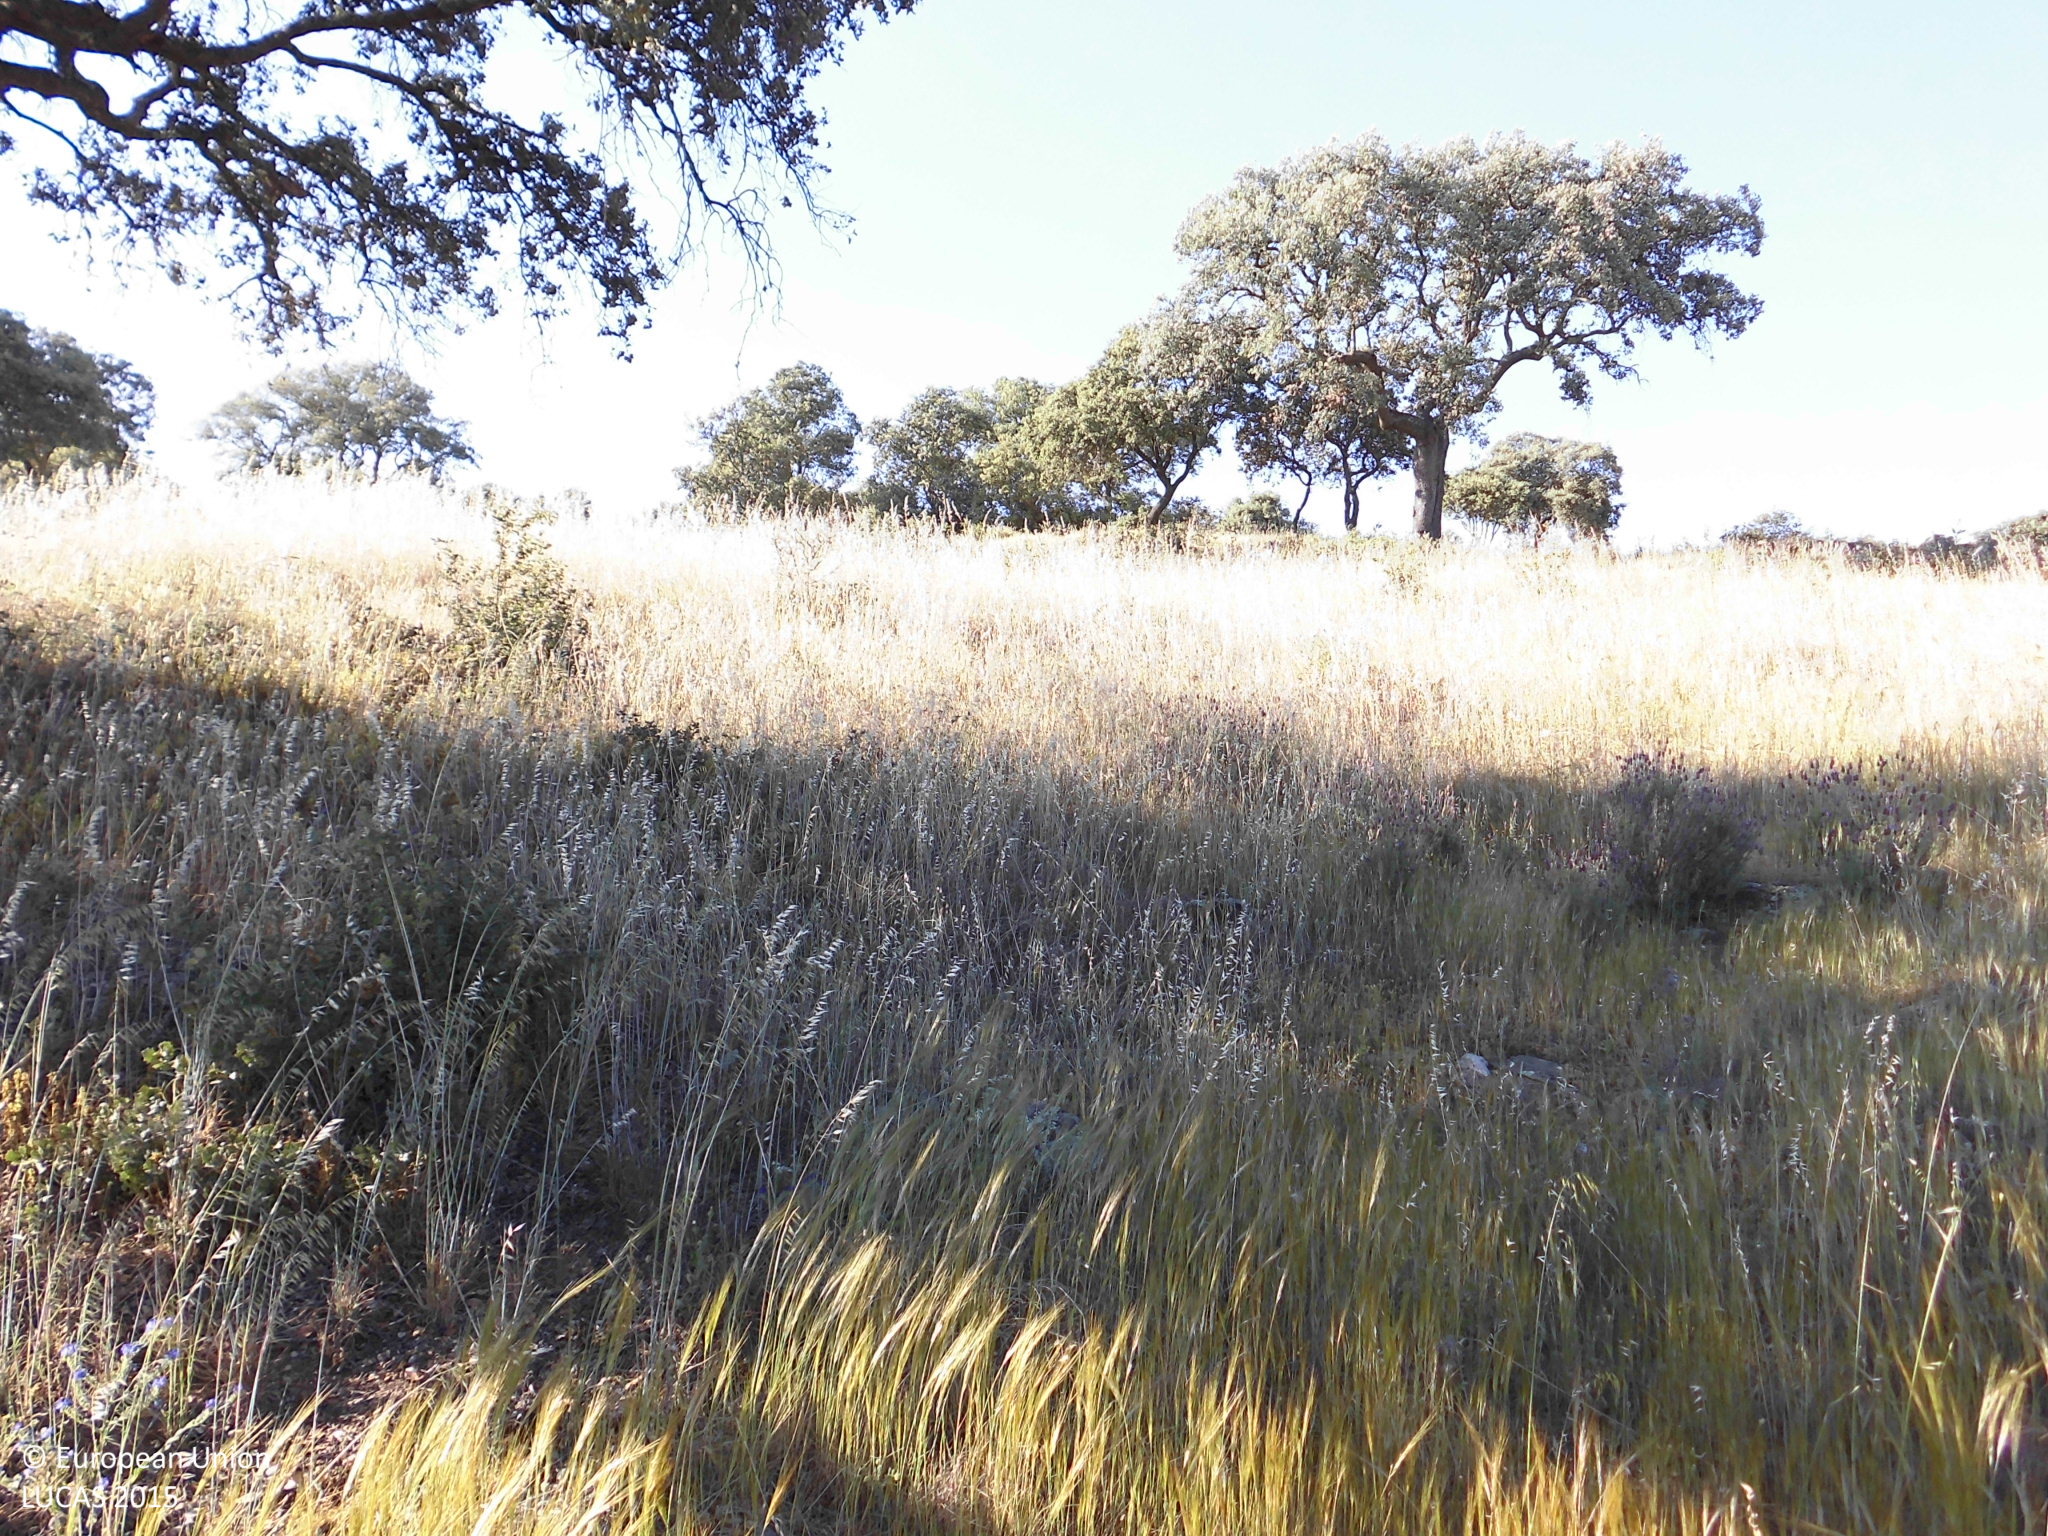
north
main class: Woodland
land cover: Broadleaved woodland
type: broadleaved evergreen forest
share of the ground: 10 - 25 %
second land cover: Grassland without tree/shrub cover
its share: > 75 %
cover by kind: herbaceous plants 70 %, broadleaved forest trees 25 %, shrubs 5 %
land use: Forestry
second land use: Agriculture (excluding fallow land and kitchen gardens)
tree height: > 5 m
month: May
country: ES
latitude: 39.4986
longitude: -6.0989
